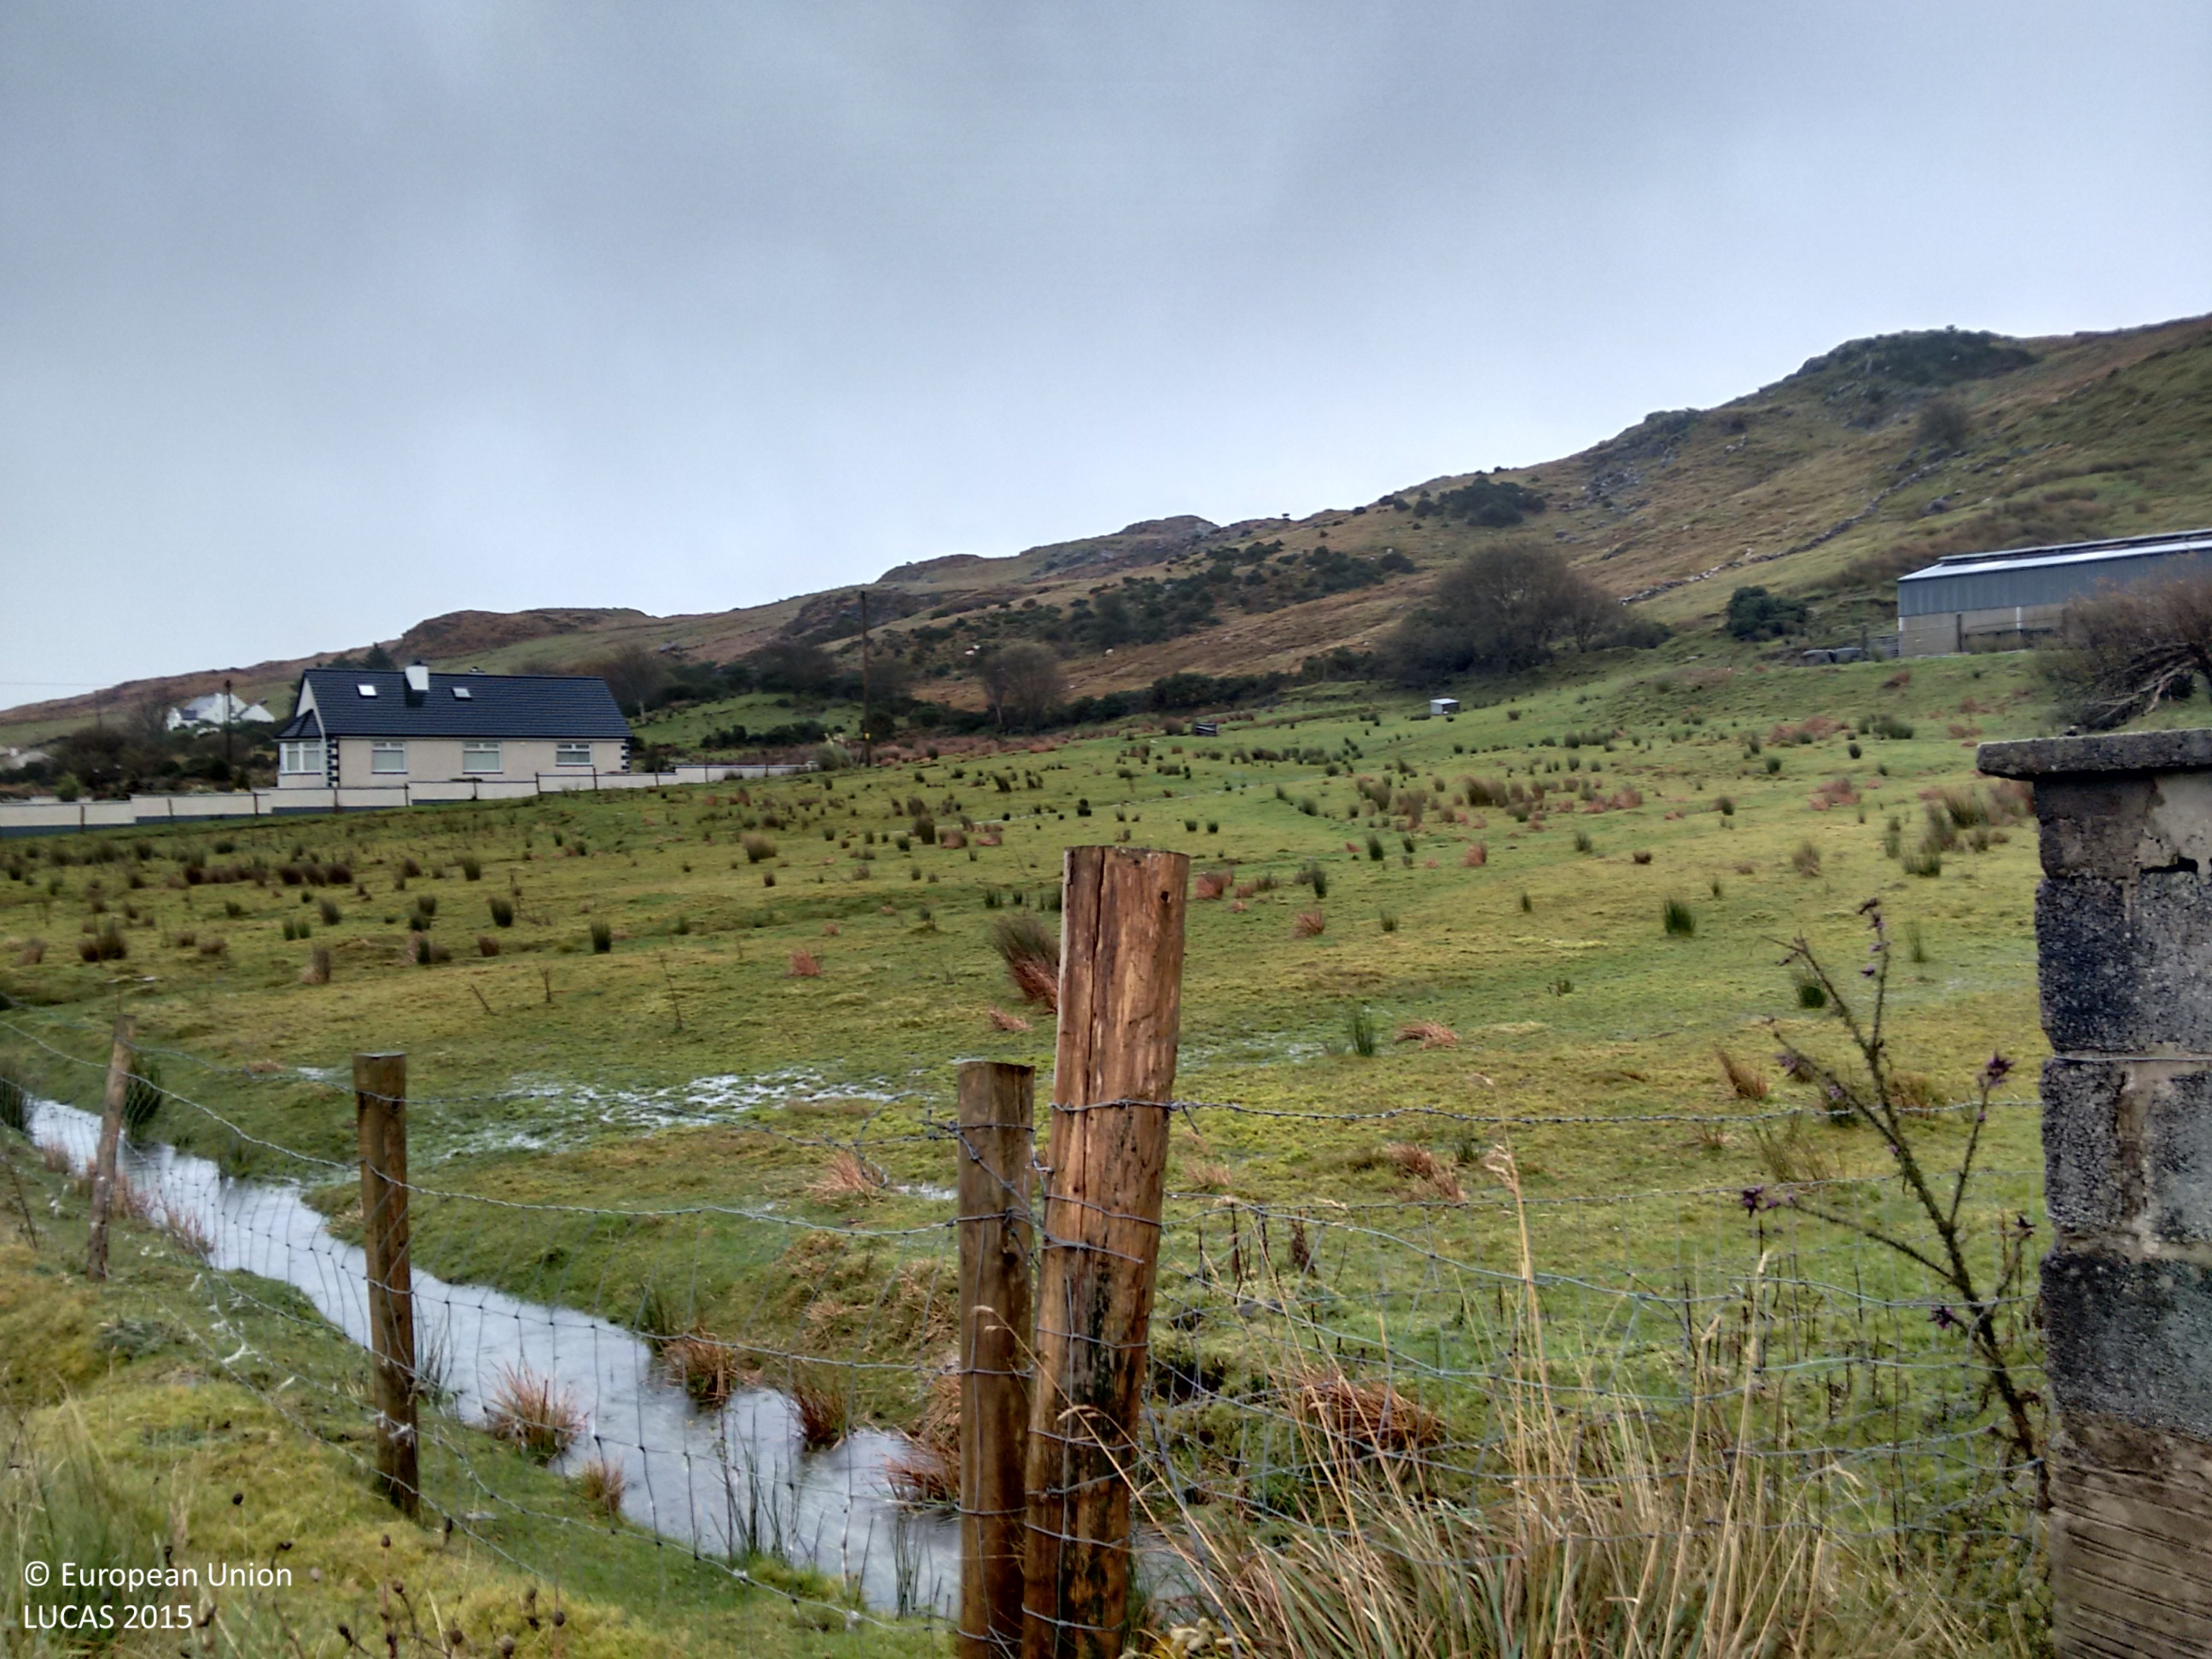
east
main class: Grassland
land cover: Grassland without tree/shrub cover
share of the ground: > 75 %
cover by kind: herbaceous plants 80 %, lichens and mosses 20 %
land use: Agriculture (excluding fallow land and kitchen gardens)
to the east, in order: Grassland without tree/shrub cover; Rivers and streams; Grassland without tree/shrub cover; Dry stone walls; Grassland without tree/shrub cover; Rivers and streams; Grassland without tree/shrub cover
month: November
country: IE
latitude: 54.7403
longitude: -8.4391
